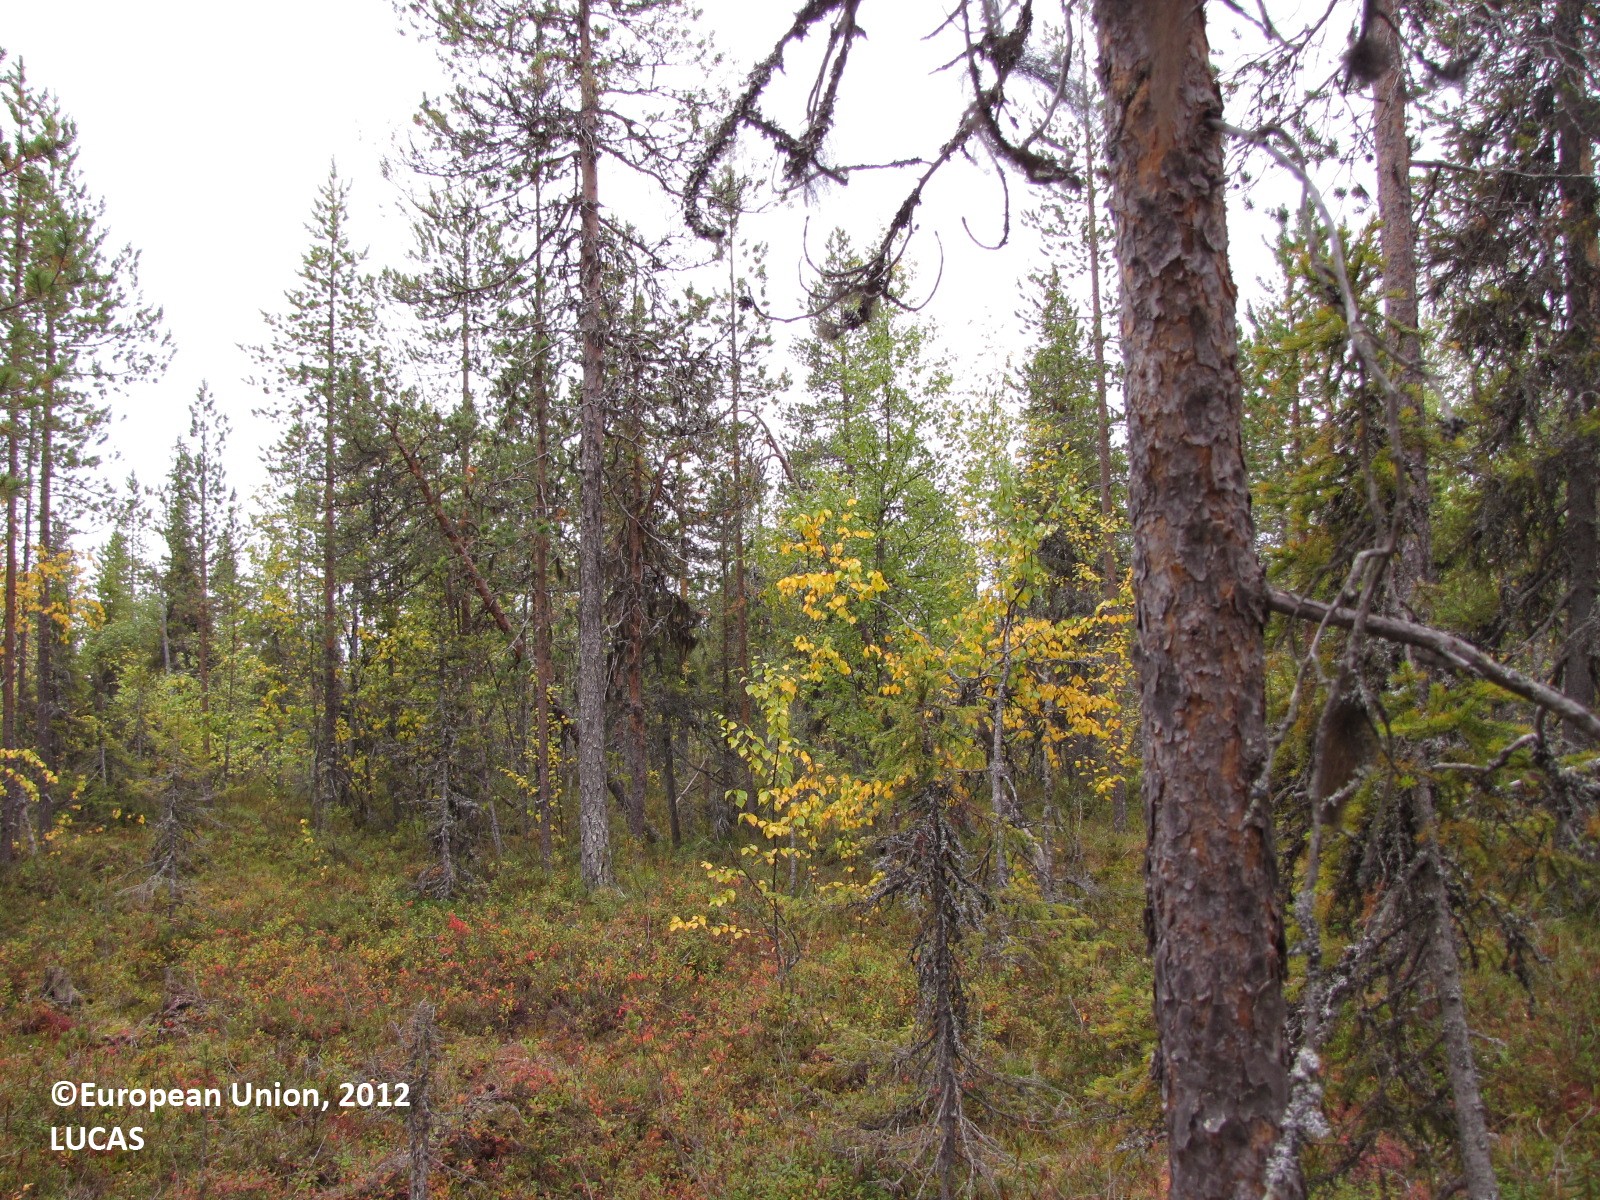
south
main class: Woodland
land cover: Pine dominated mixed woodland
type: boreal forest
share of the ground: 25 - 50 %
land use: Forestry
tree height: > 5 m
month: September
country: FI
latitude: 67.2299
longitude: 25.2129
